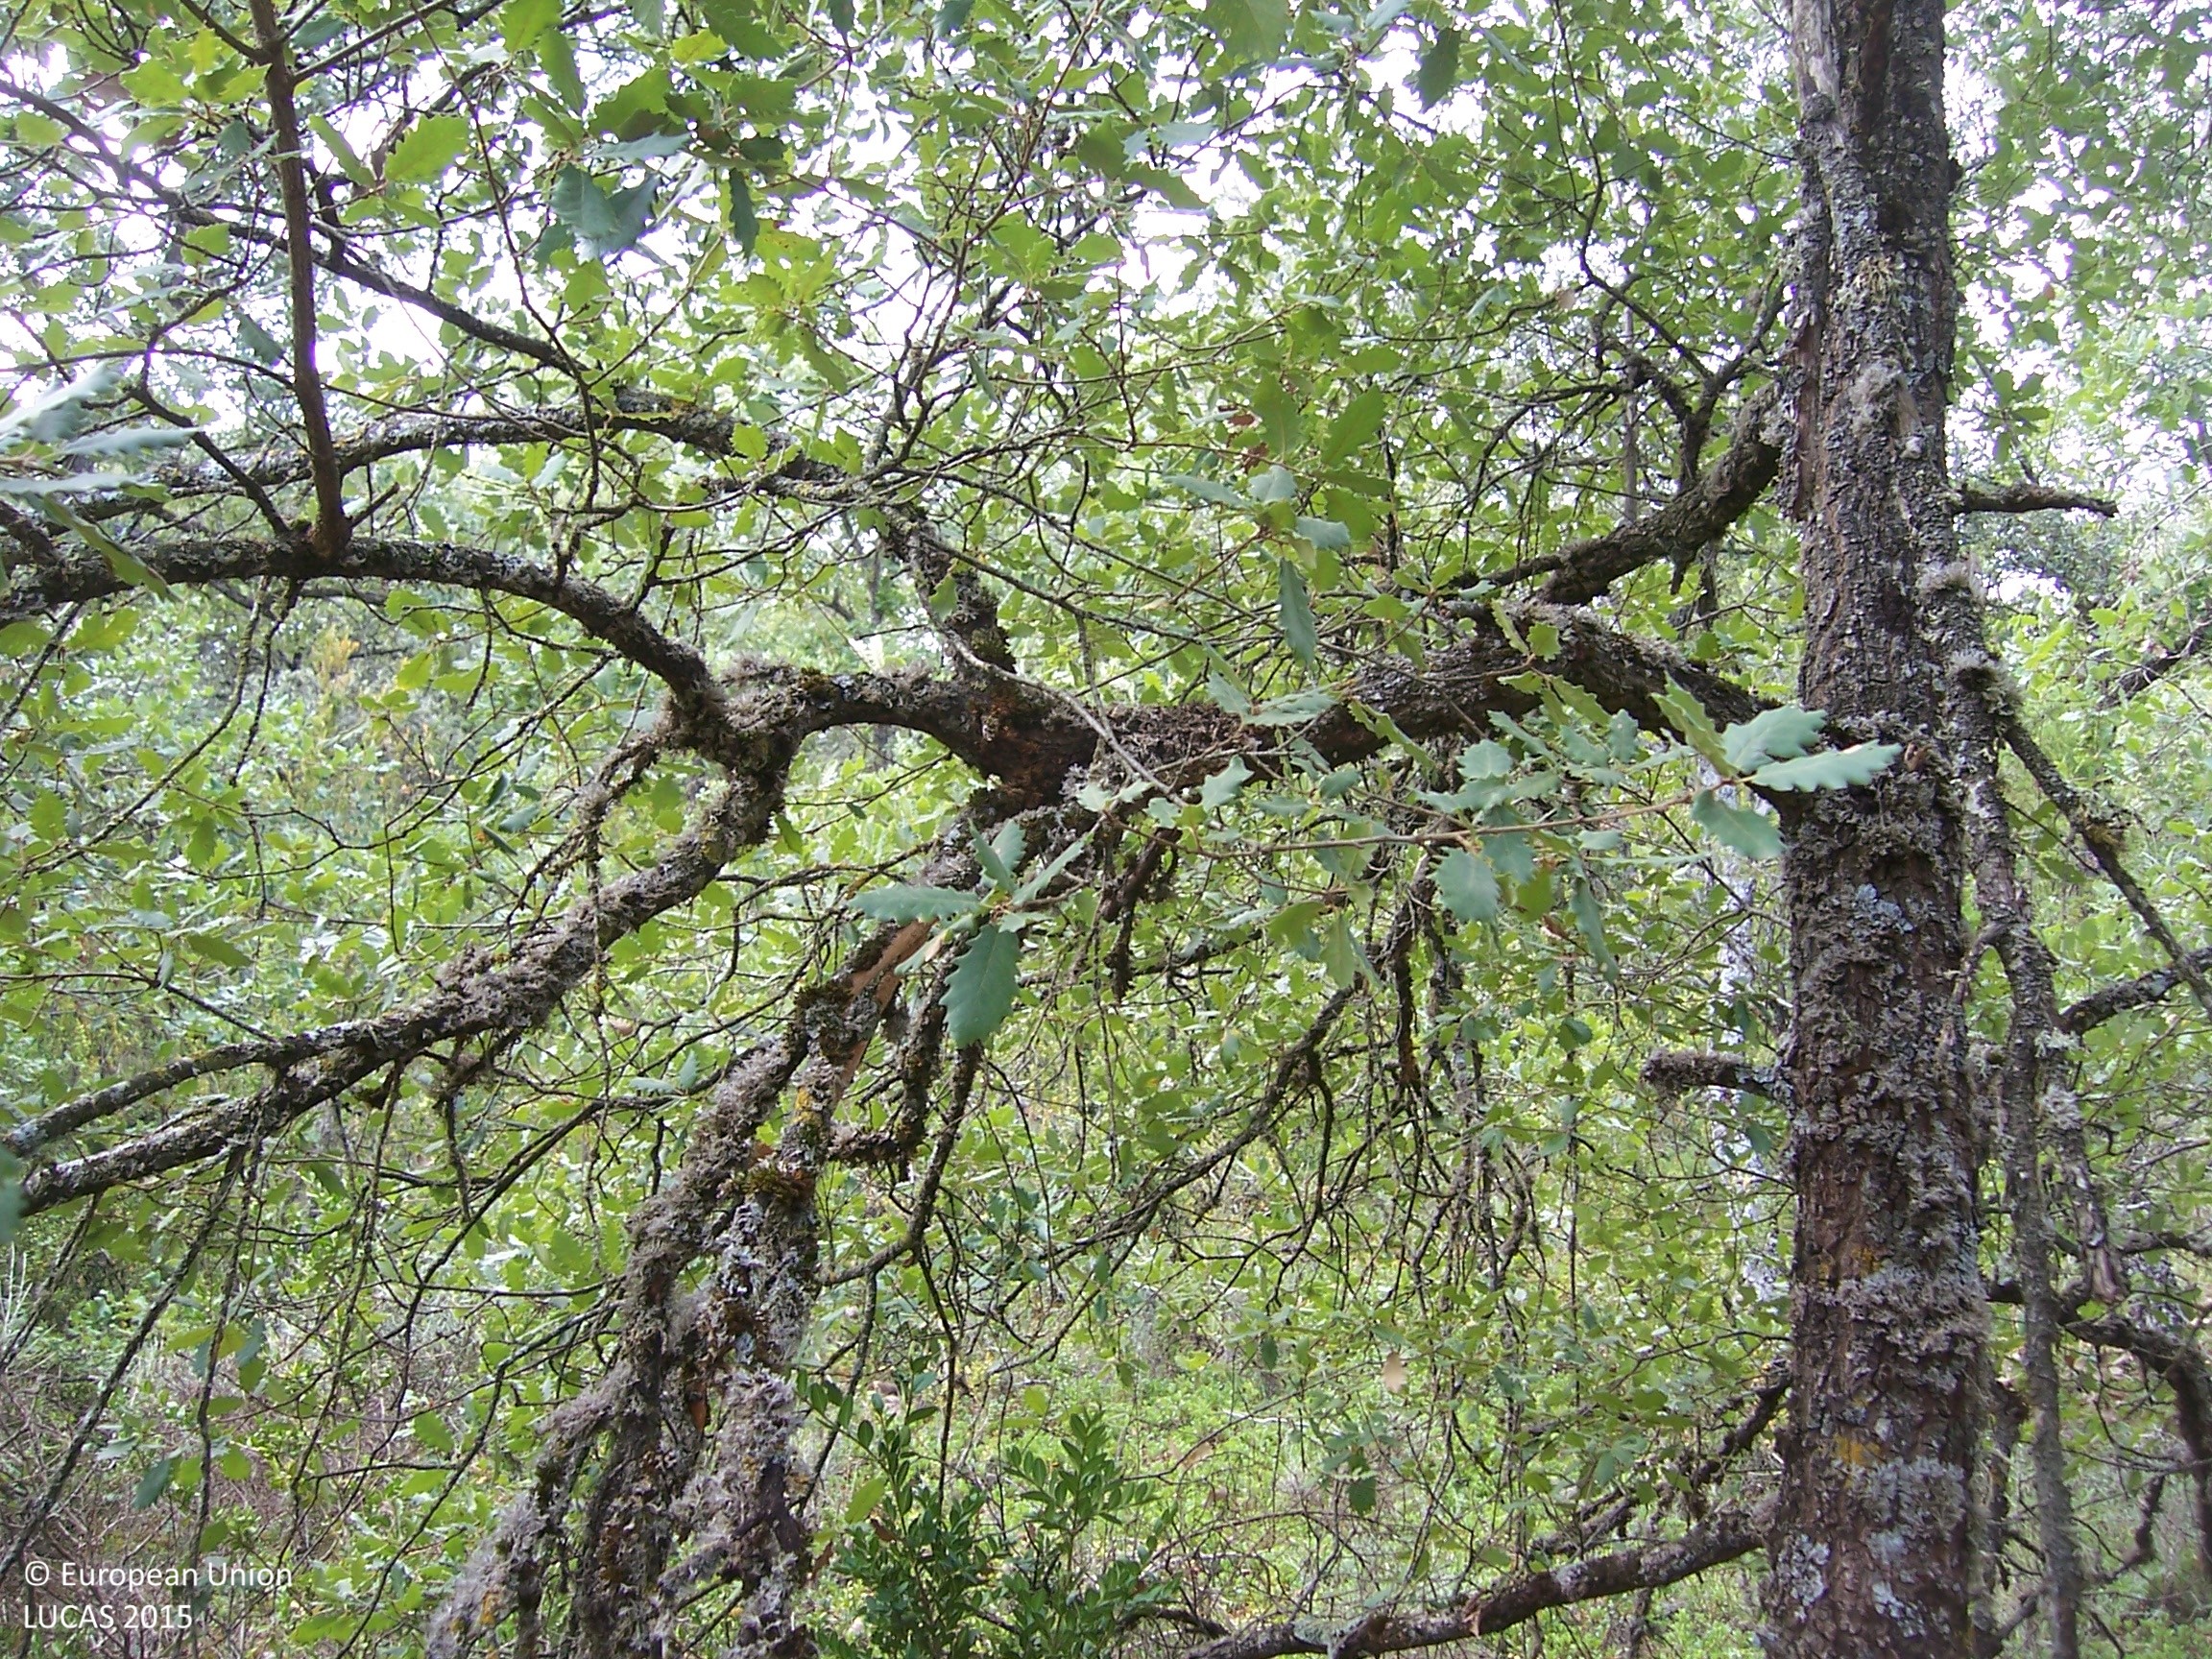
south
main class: Woodland
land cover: Broadleaved woodland
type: broadleaved evergreen forest
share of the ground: > 75 %
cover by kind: broadleaved forest trees 80 %, shrubs 10 %, herbaceous plants 10 %
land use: Semi-natural and natural areas not in use
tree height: > 5 m
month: August
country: ES
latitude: 42.0587
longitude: 0.4735
